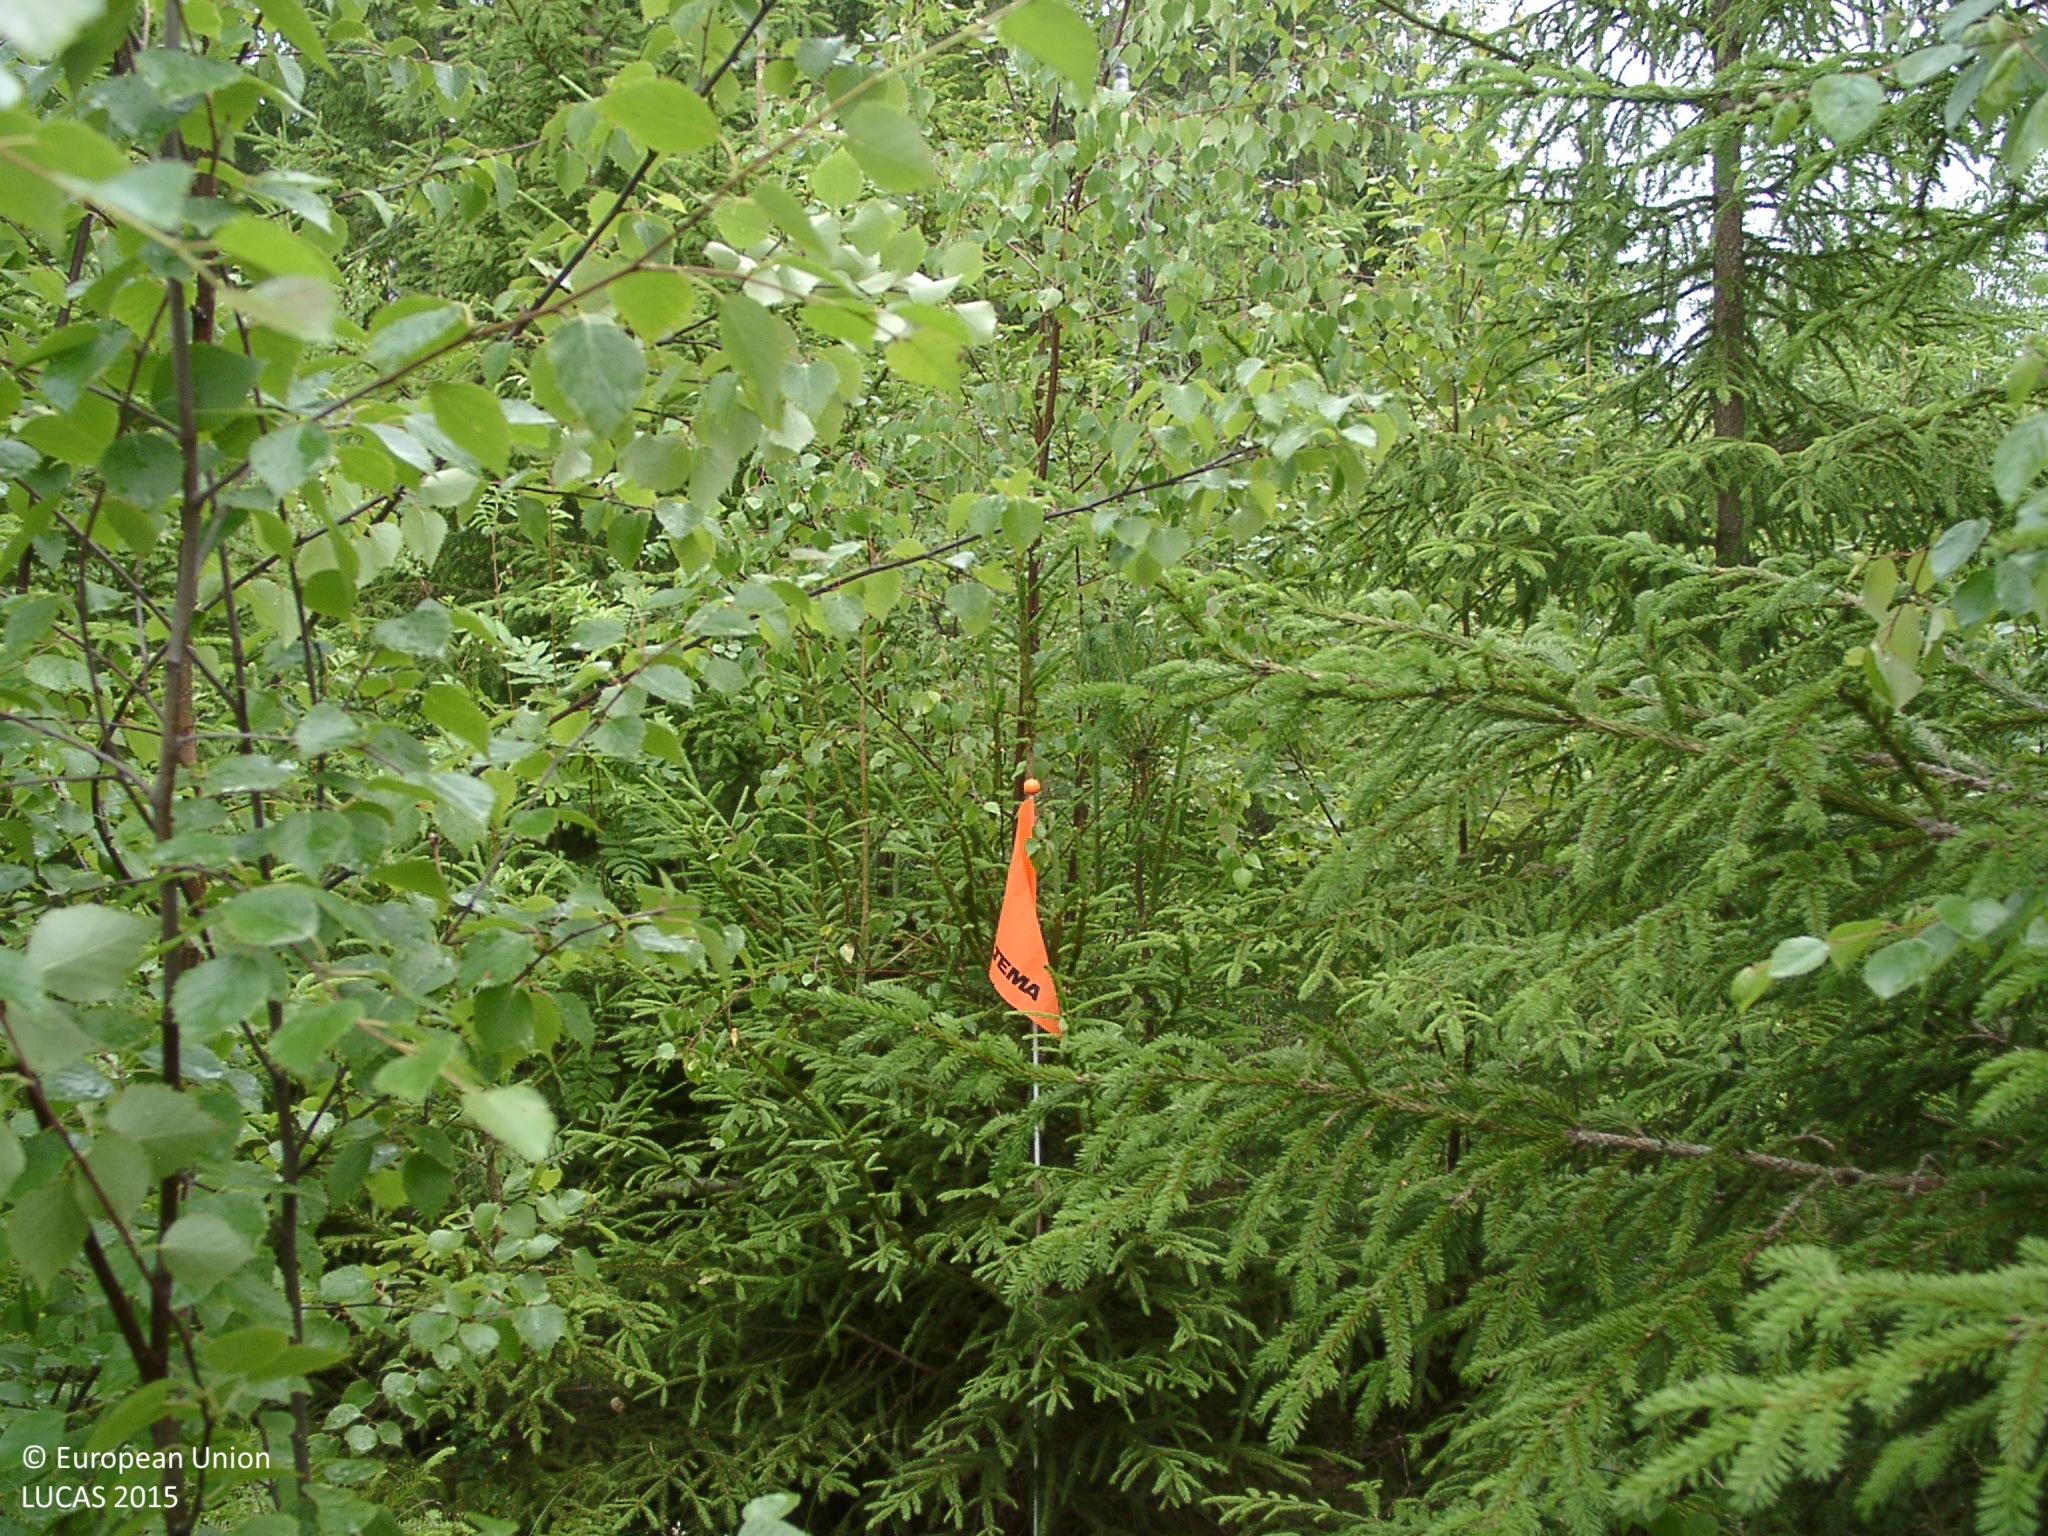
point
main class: Woodland
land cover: Spruce dominated mixed woodland
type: boreal forest
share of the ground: > 75 %
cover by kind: broadleaved forest trees 45 %, coniferous forest trees 40 %, shrubs 10 %, herbaceous plants 5 %
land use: Forestry
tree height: < 5 m
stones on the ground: < 10 %
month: July
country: FI
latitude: 61.5450
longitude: 25.1446
